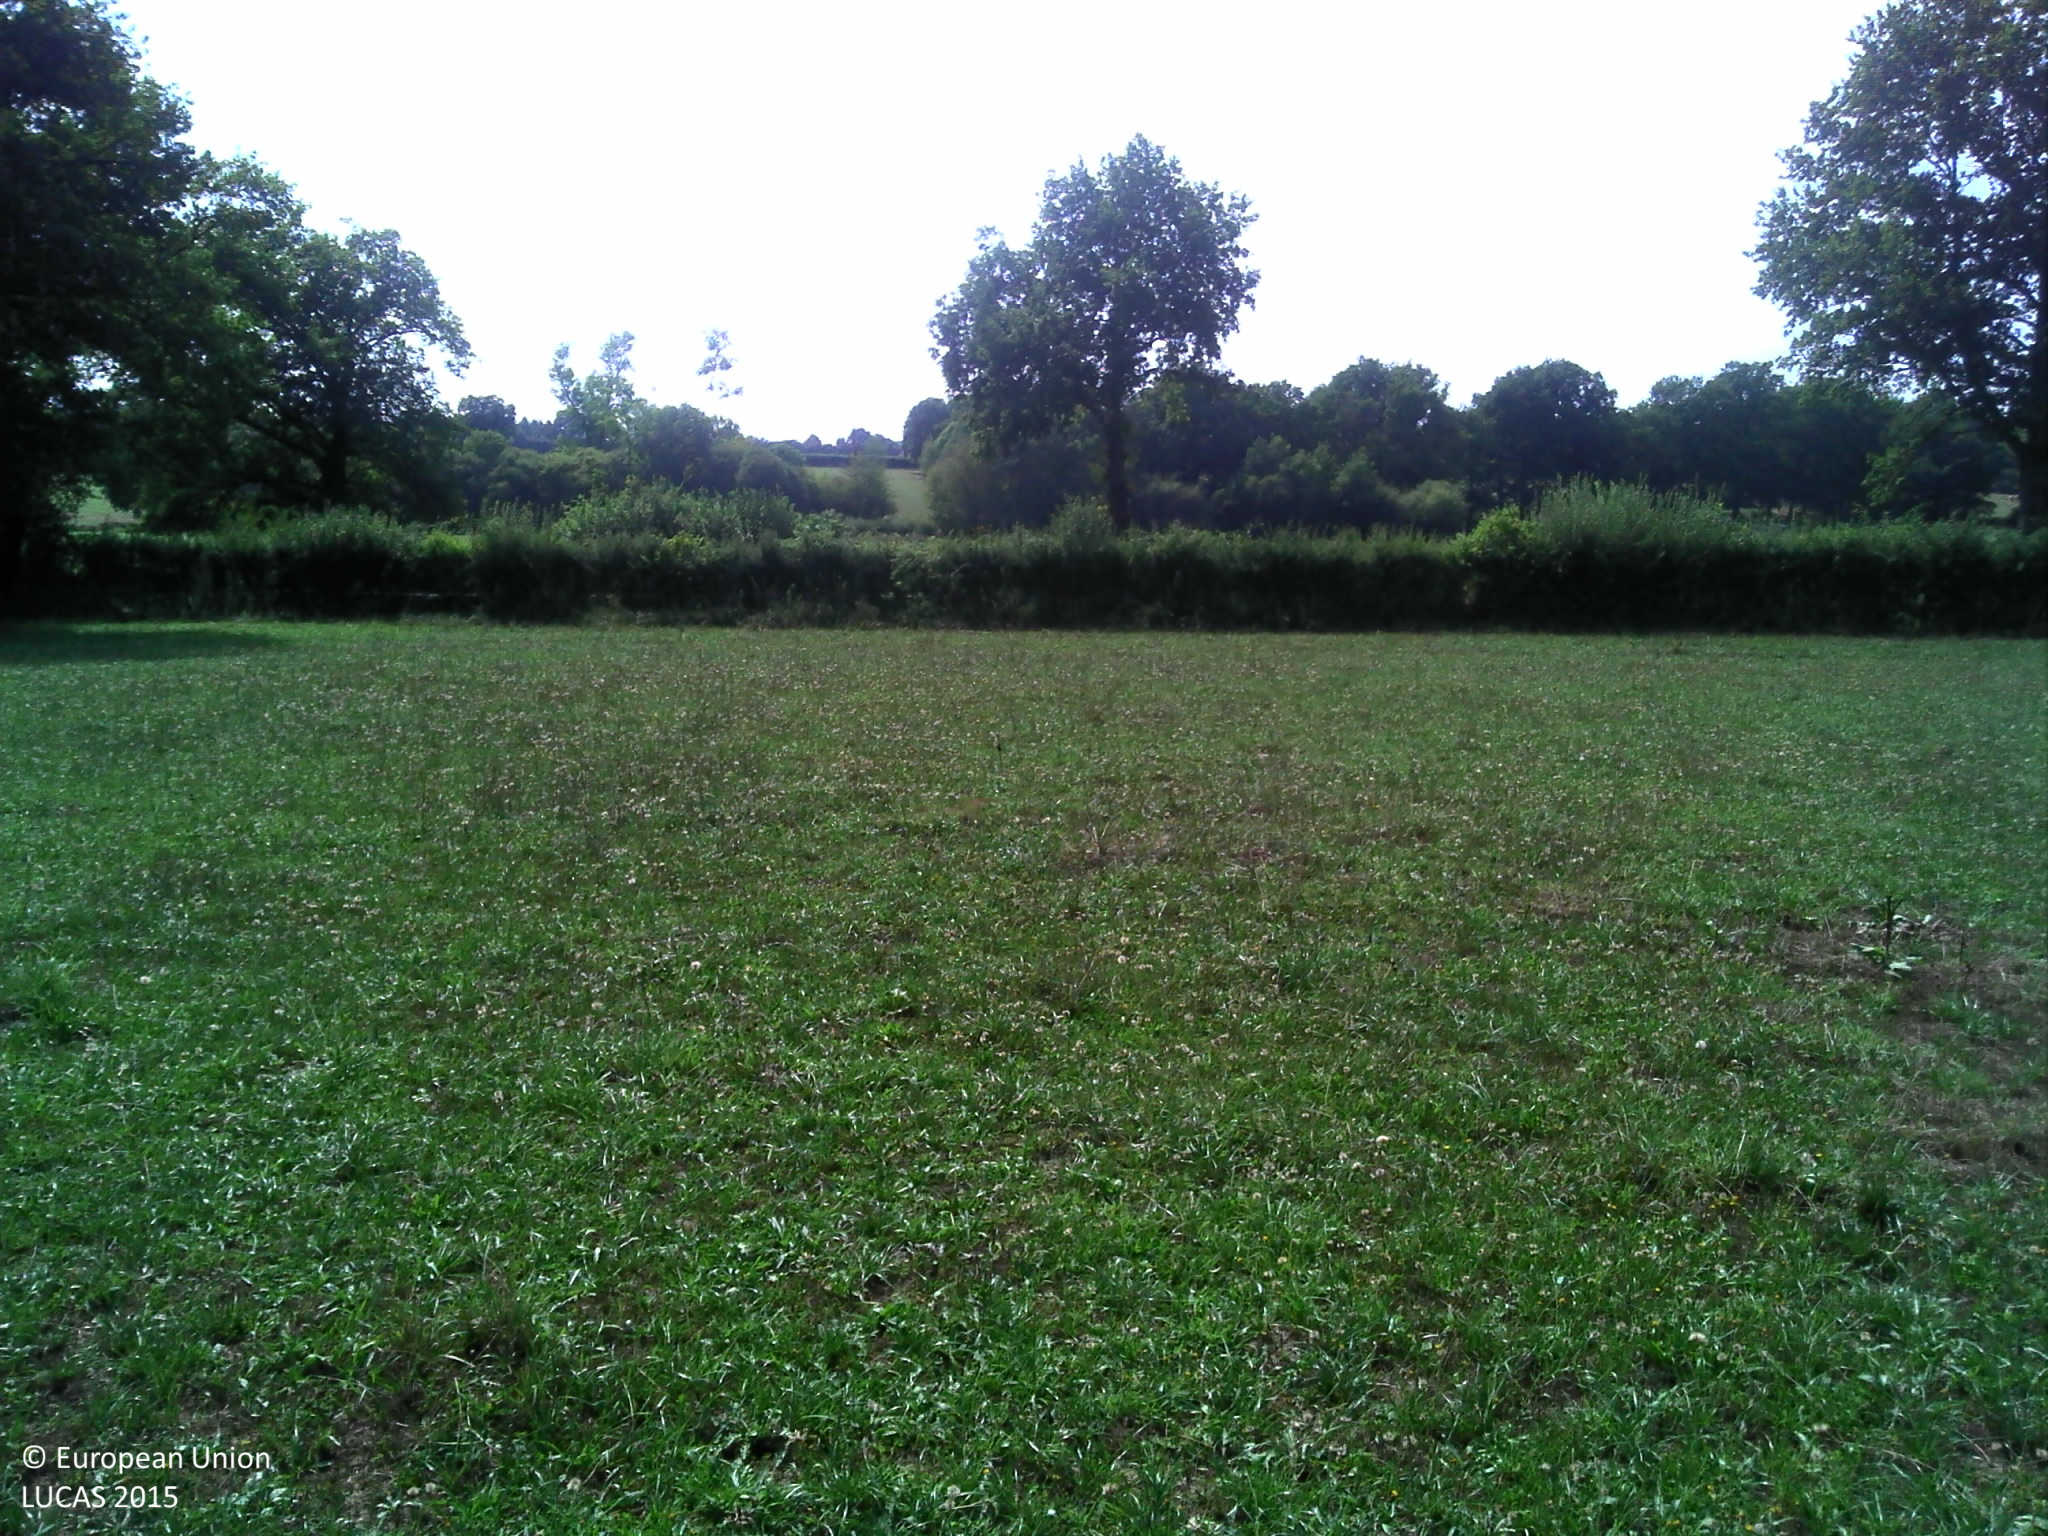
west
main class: Grassland
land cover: Grassland without tree/shrub cover
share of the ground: > 75 %
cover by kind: herbaceous plants 100 %
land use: Agriculture (excluding fallow land and kitchen gardens)
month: August
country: FR
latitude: 46.2328
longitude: 2.2535
